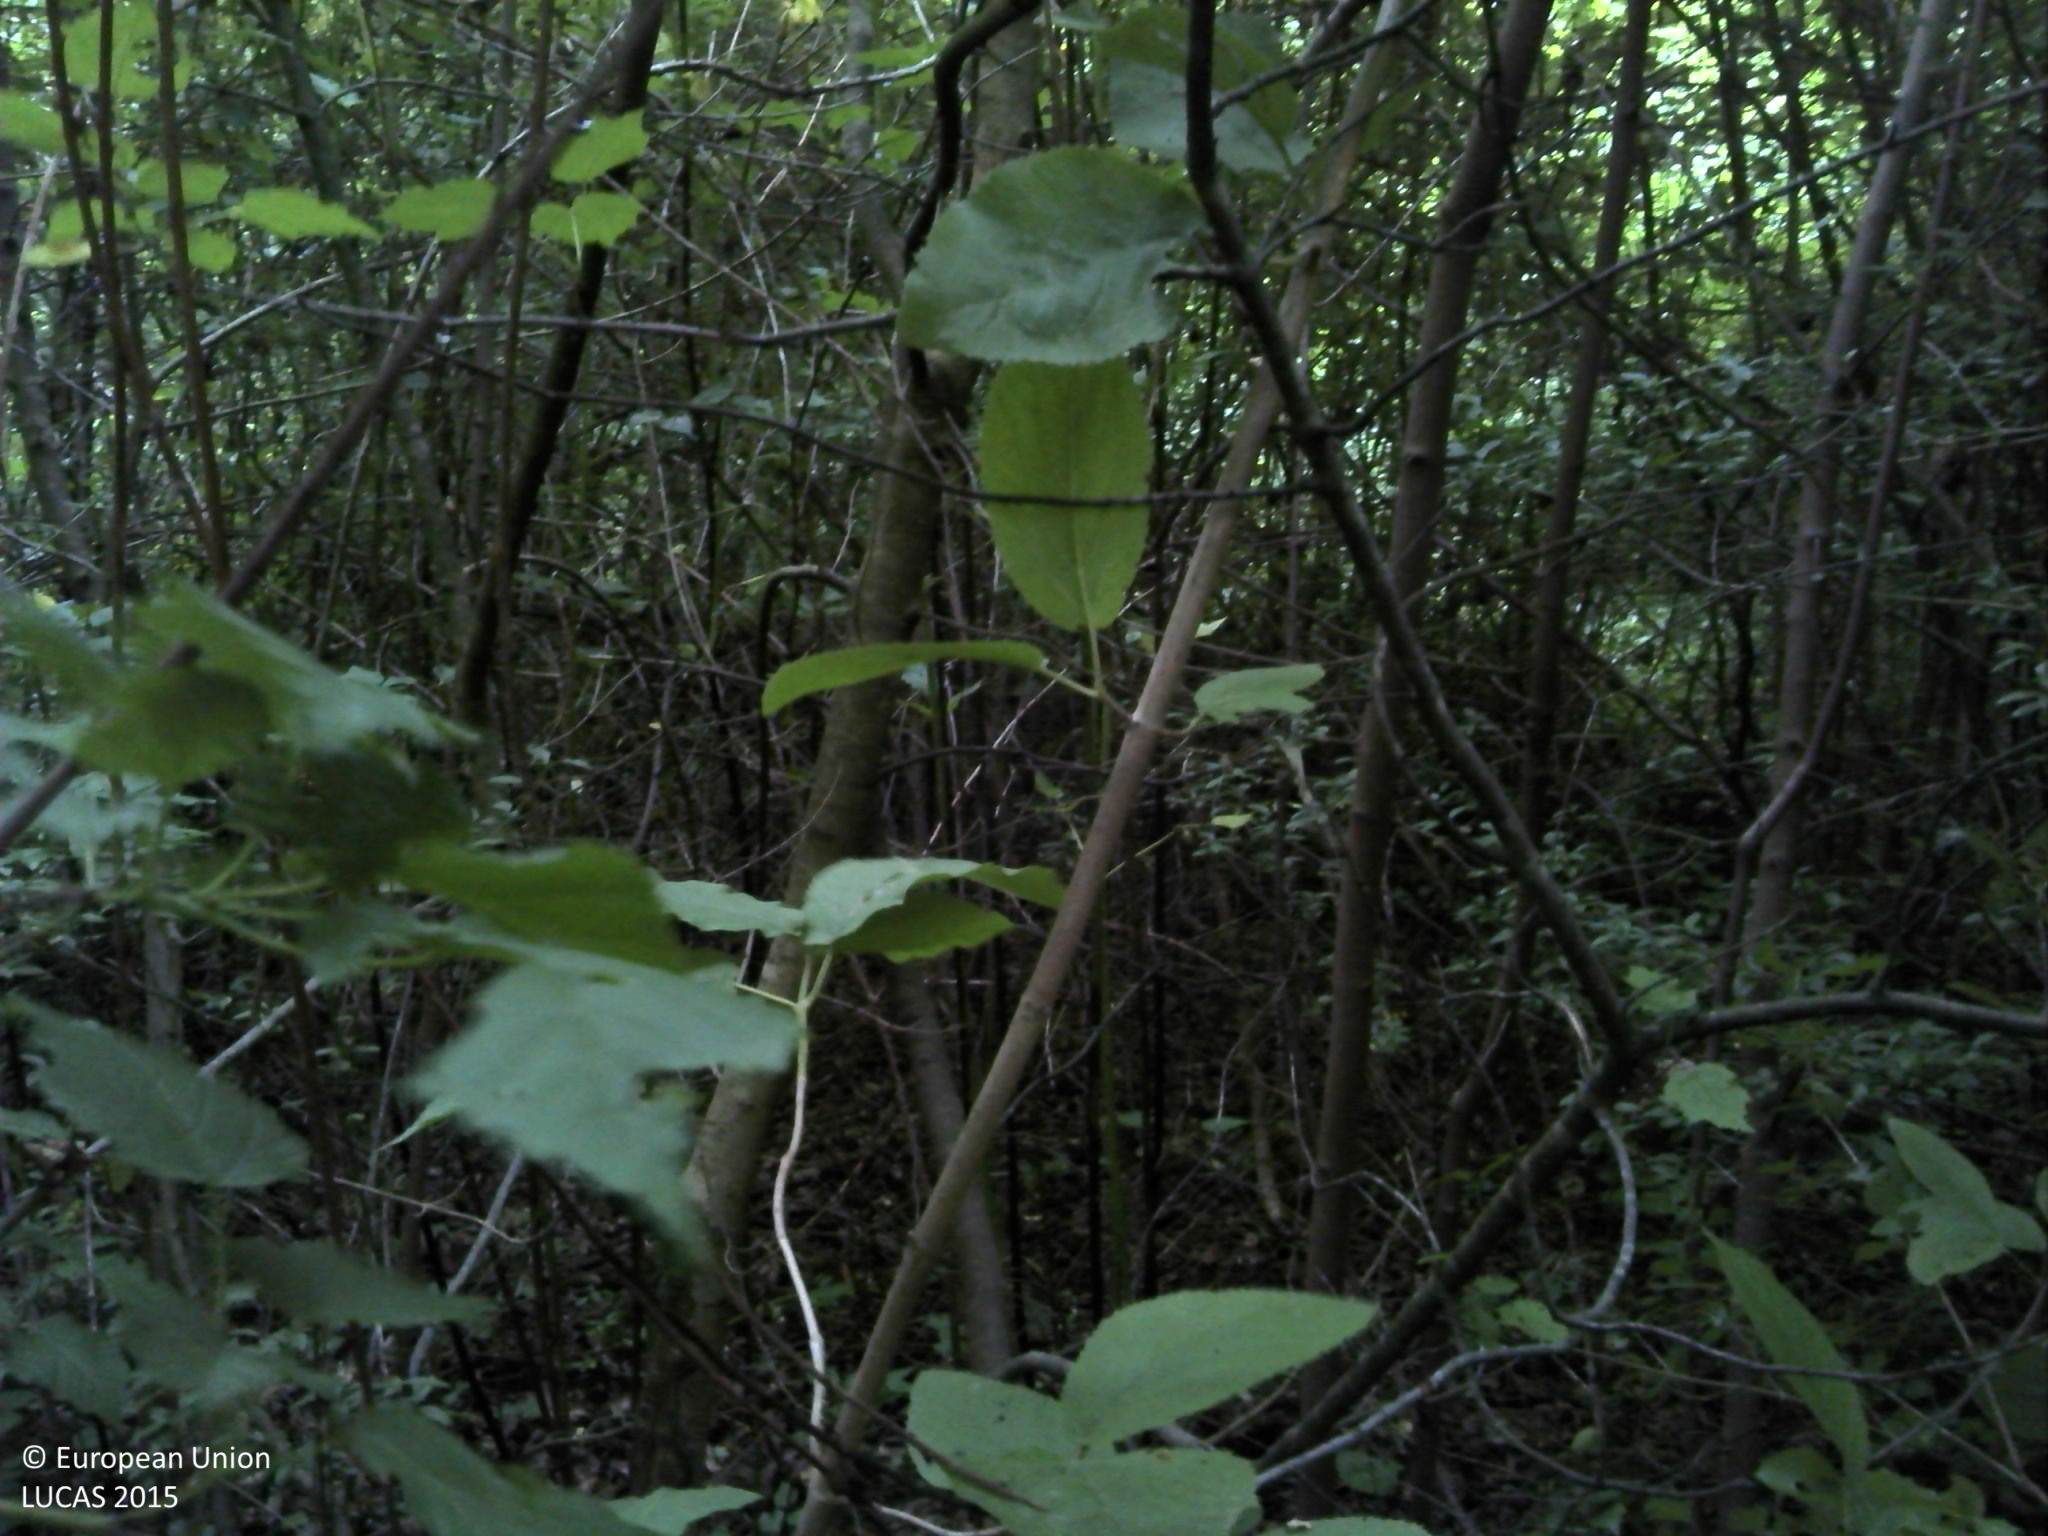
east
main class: Woodland
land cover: Broadleaved woodland
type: beech forest
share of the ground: > 75 %
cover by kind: broadleaved forest trees 100 %
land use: Forestry
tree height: > 5 m
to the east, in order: Broadleaved woodland
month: June
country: HR
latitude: 45.2508
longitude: 17.8124
